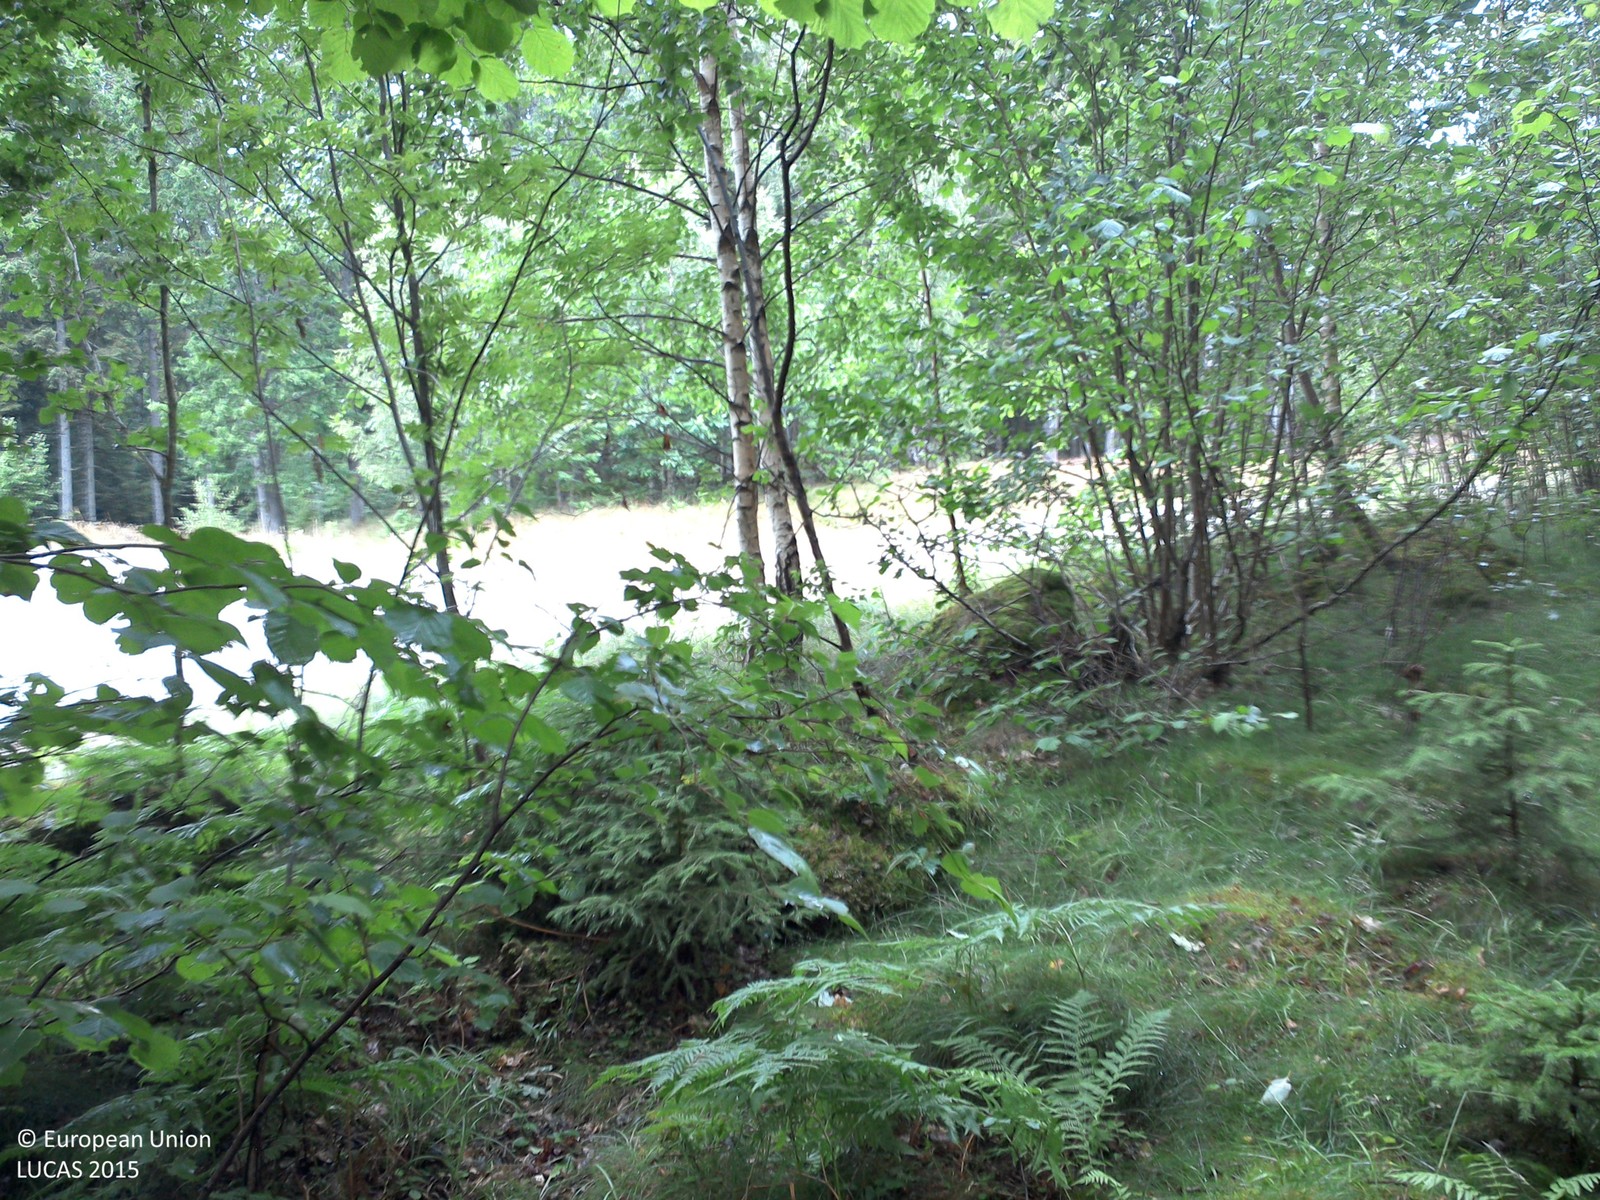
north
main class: Woodland
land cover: Broadleaved woodland
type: boreal forest
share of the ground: 50 - 75 %
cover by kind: broadleaved forest trees 60 %, herbaceous plants 40 %
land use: Forestry
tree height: > 5 m
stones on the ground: < 10 %
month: July
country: SE
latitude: 58.3070
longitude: 14.9944
